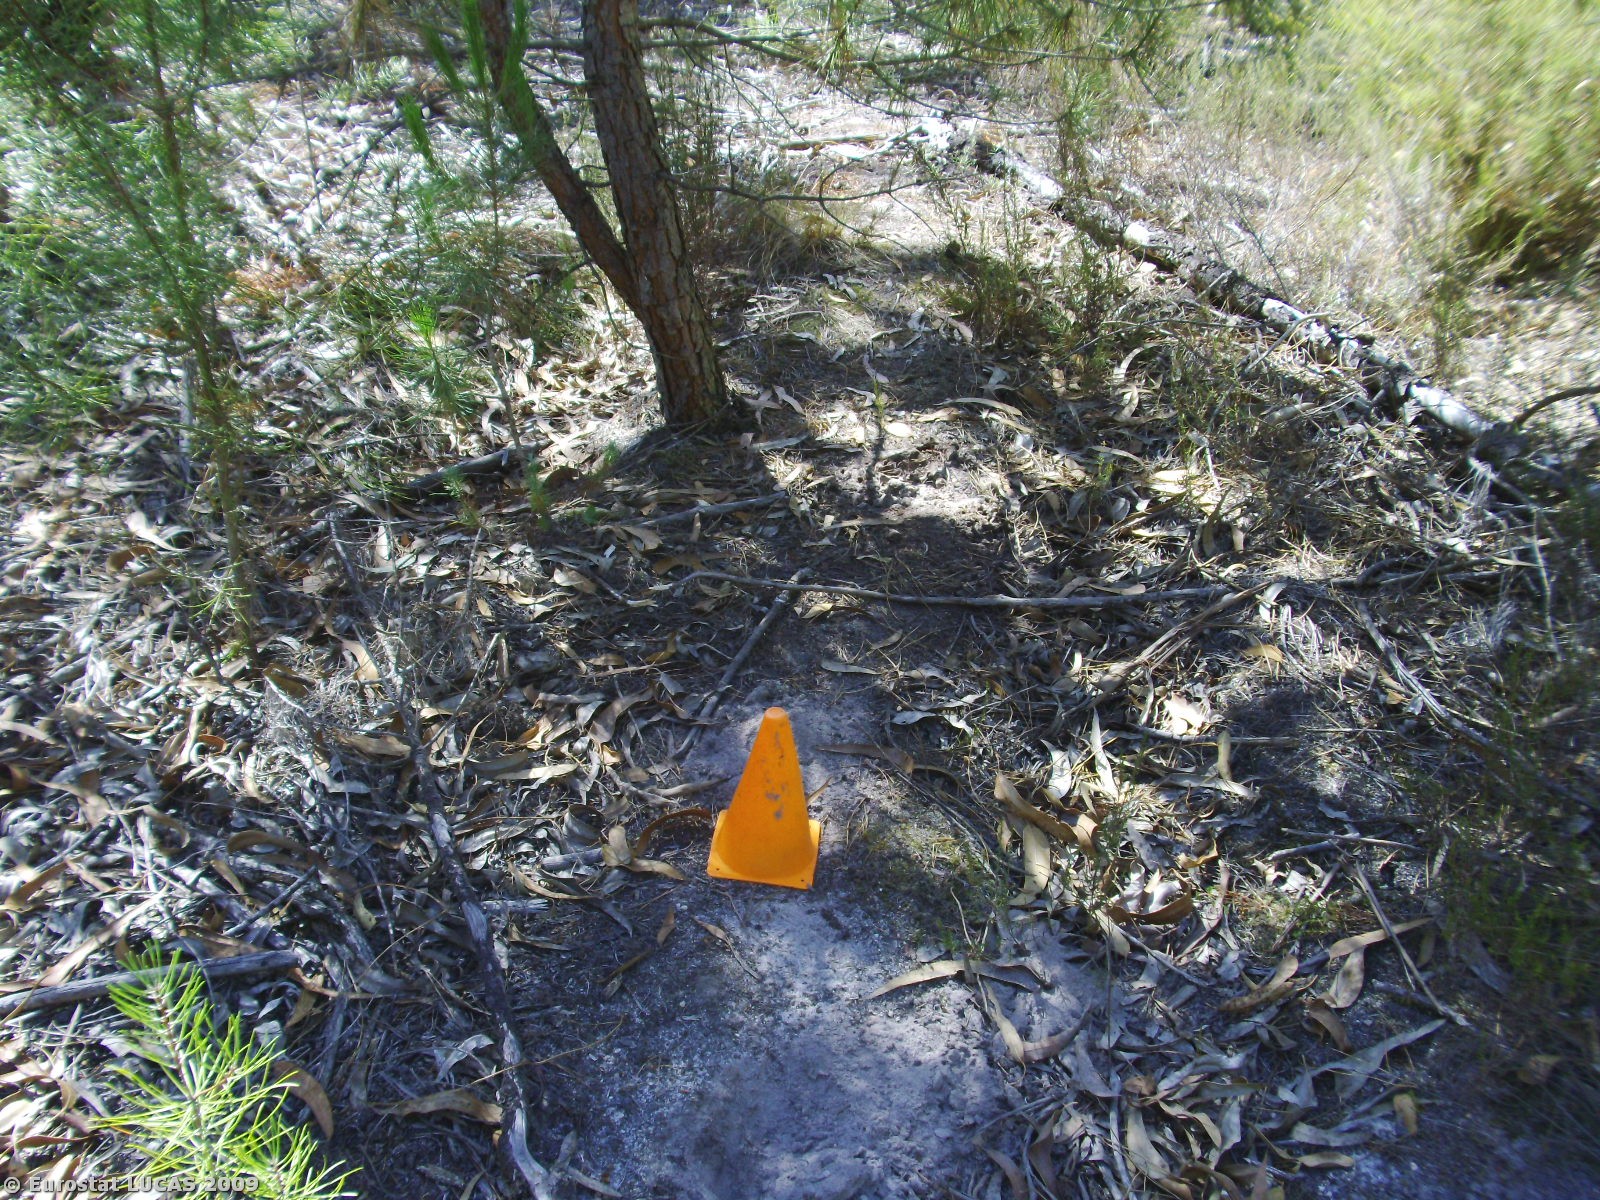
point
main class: Woodland
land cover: Mixed woodland
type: coniferous forest of the mediterranean region
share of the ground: 50 - 75 %
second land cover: Bare land
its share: 25 - 50 %
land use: Forestry
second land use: Fallow land
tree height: > 5 m
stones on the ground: < 10 %
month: August
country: PT
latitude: 38.7271
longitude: -8.7090
